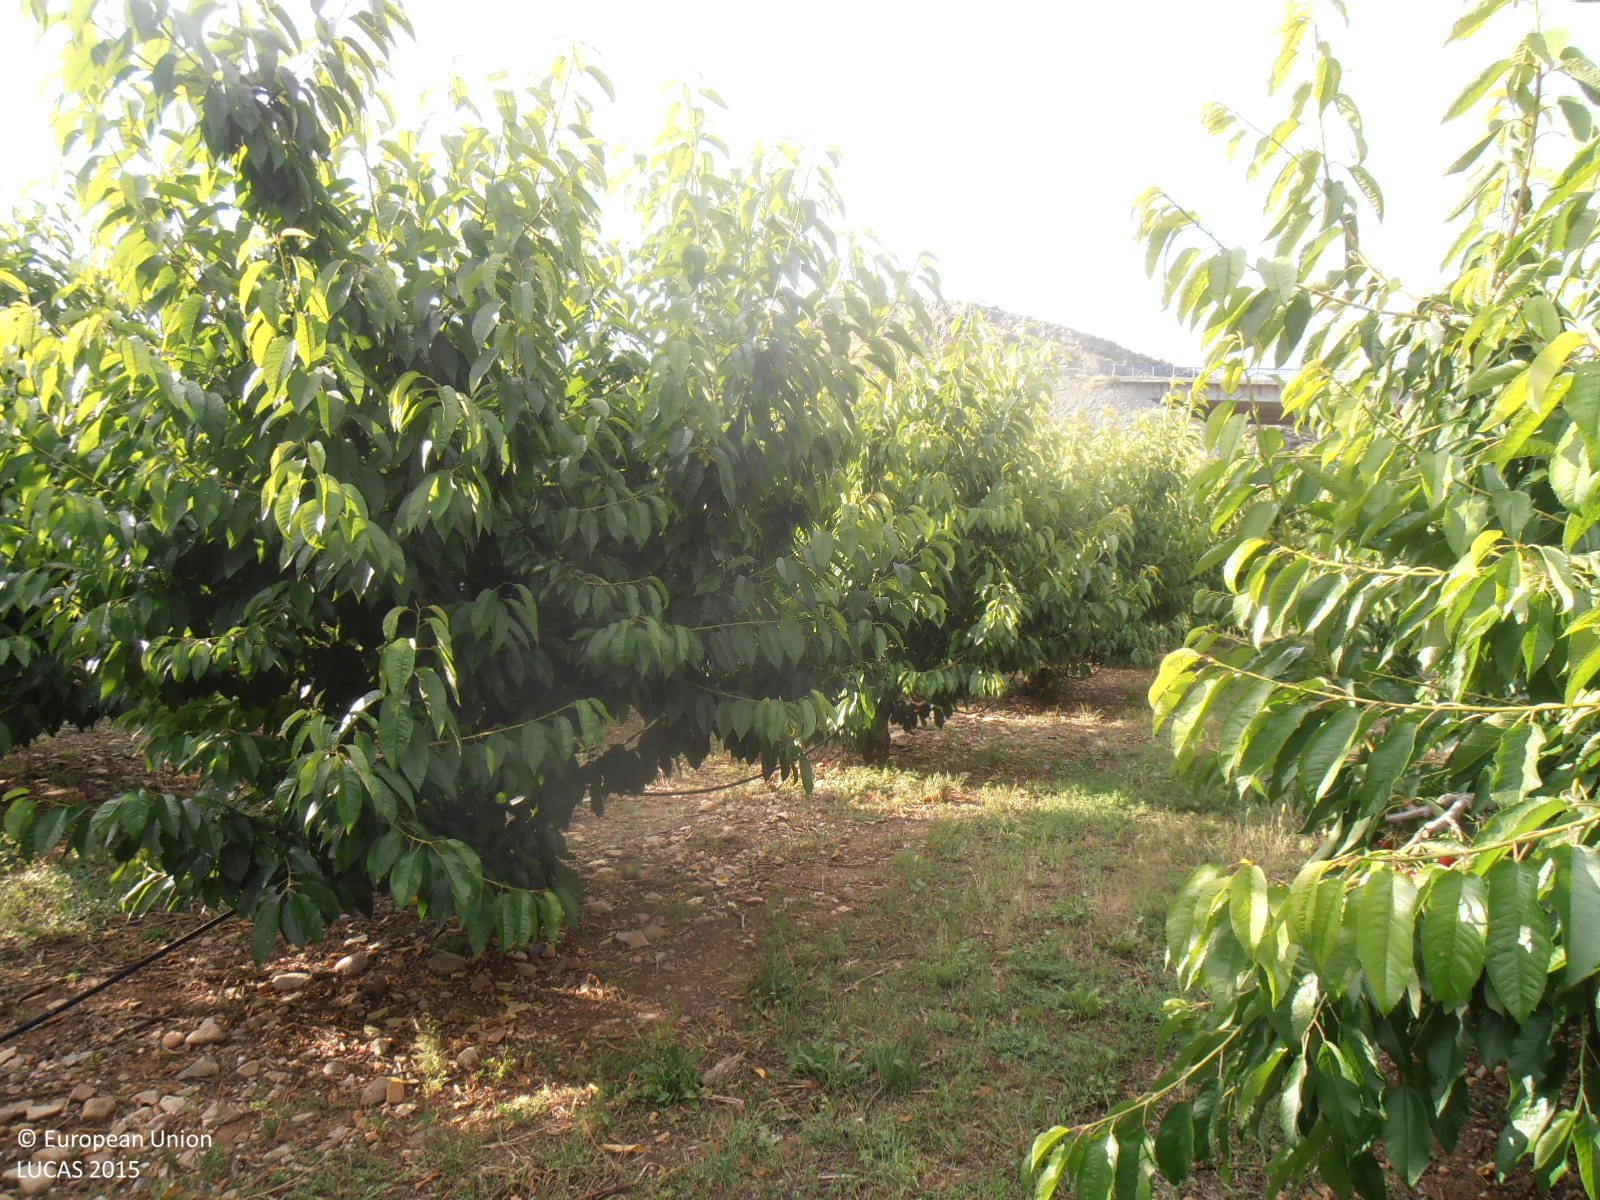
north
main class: Cropland
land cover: Cherry fruit
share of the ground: > 75 %
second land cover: Spontaneously vegetated surfaces
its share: 10 - 25 %
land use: Agriculture (excluding fallow land and kitchen gardens)
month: June
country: ES
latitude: 41.4781
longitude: -1.4131
